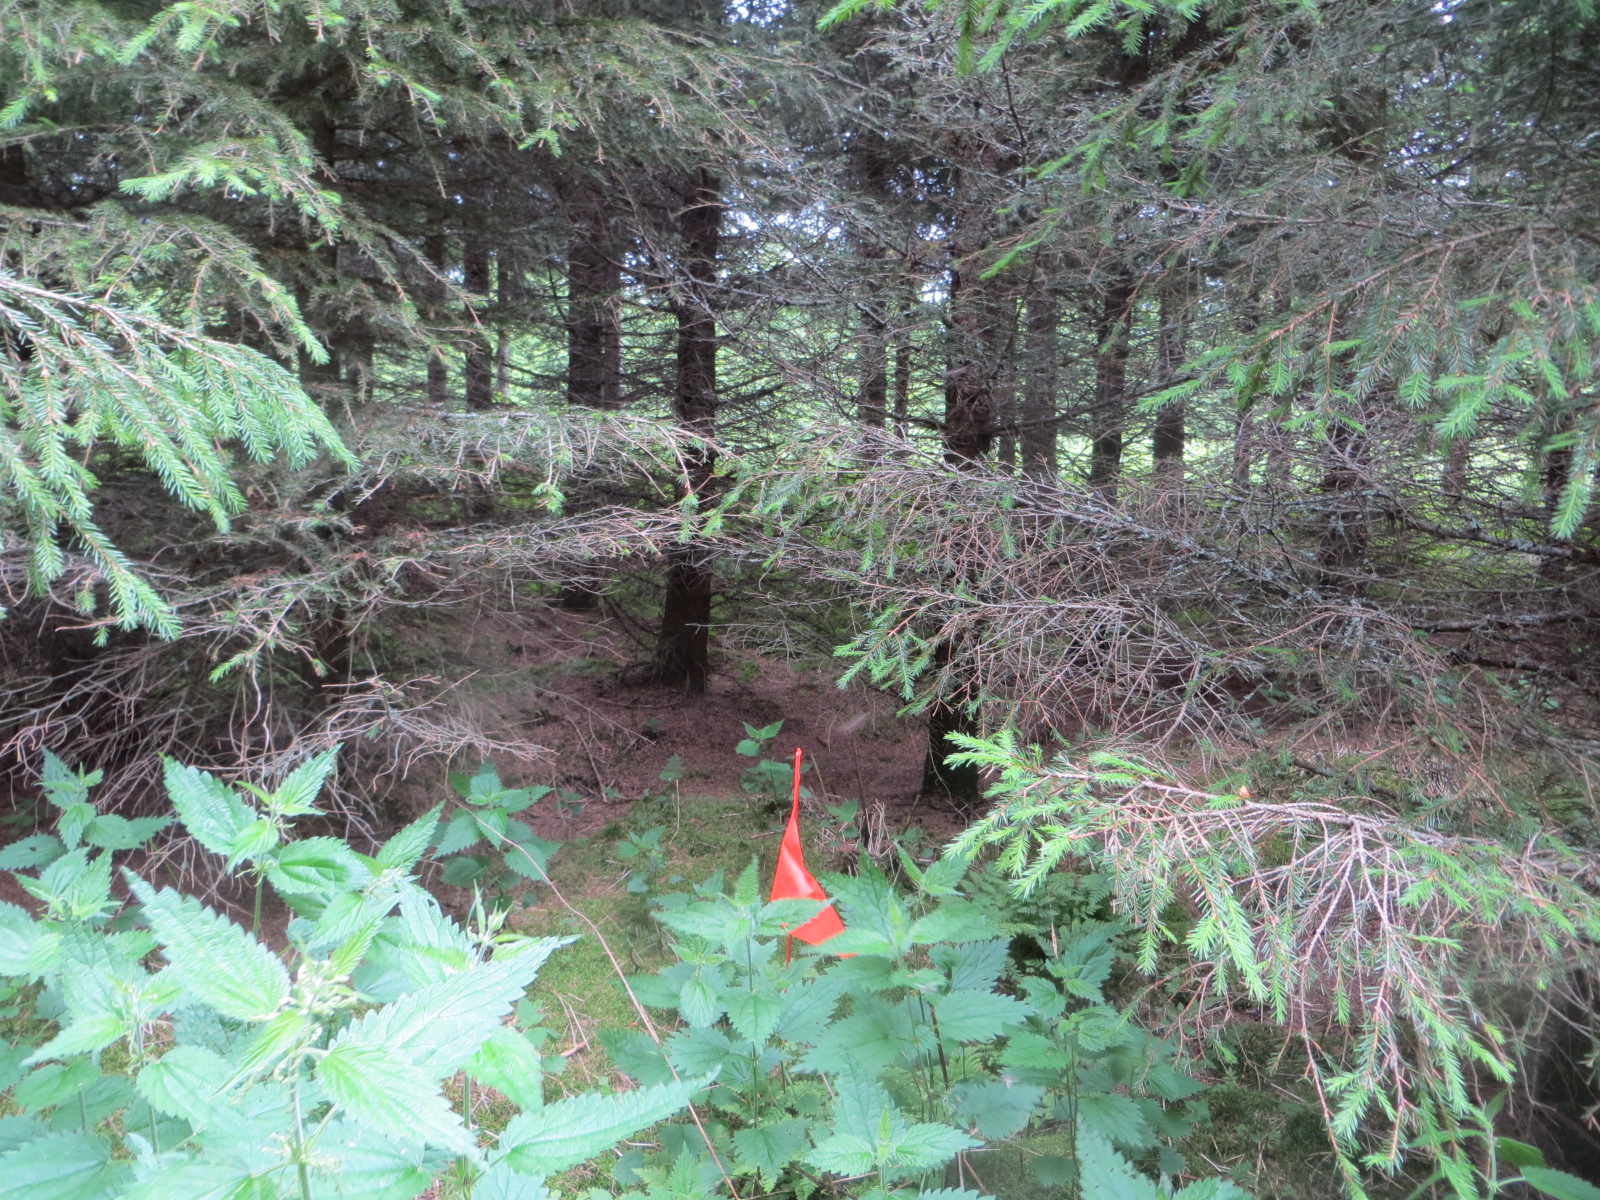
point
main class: Woodland
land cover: Spruce dominated coniferous woodland
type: boreal forest
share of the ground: > 75 %
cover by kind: coniferous forest trees 90 %, shrubs 10 %
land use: Forestry
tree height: > 5 m
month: July
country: FI
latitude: 65.7769
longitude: 25.2938
